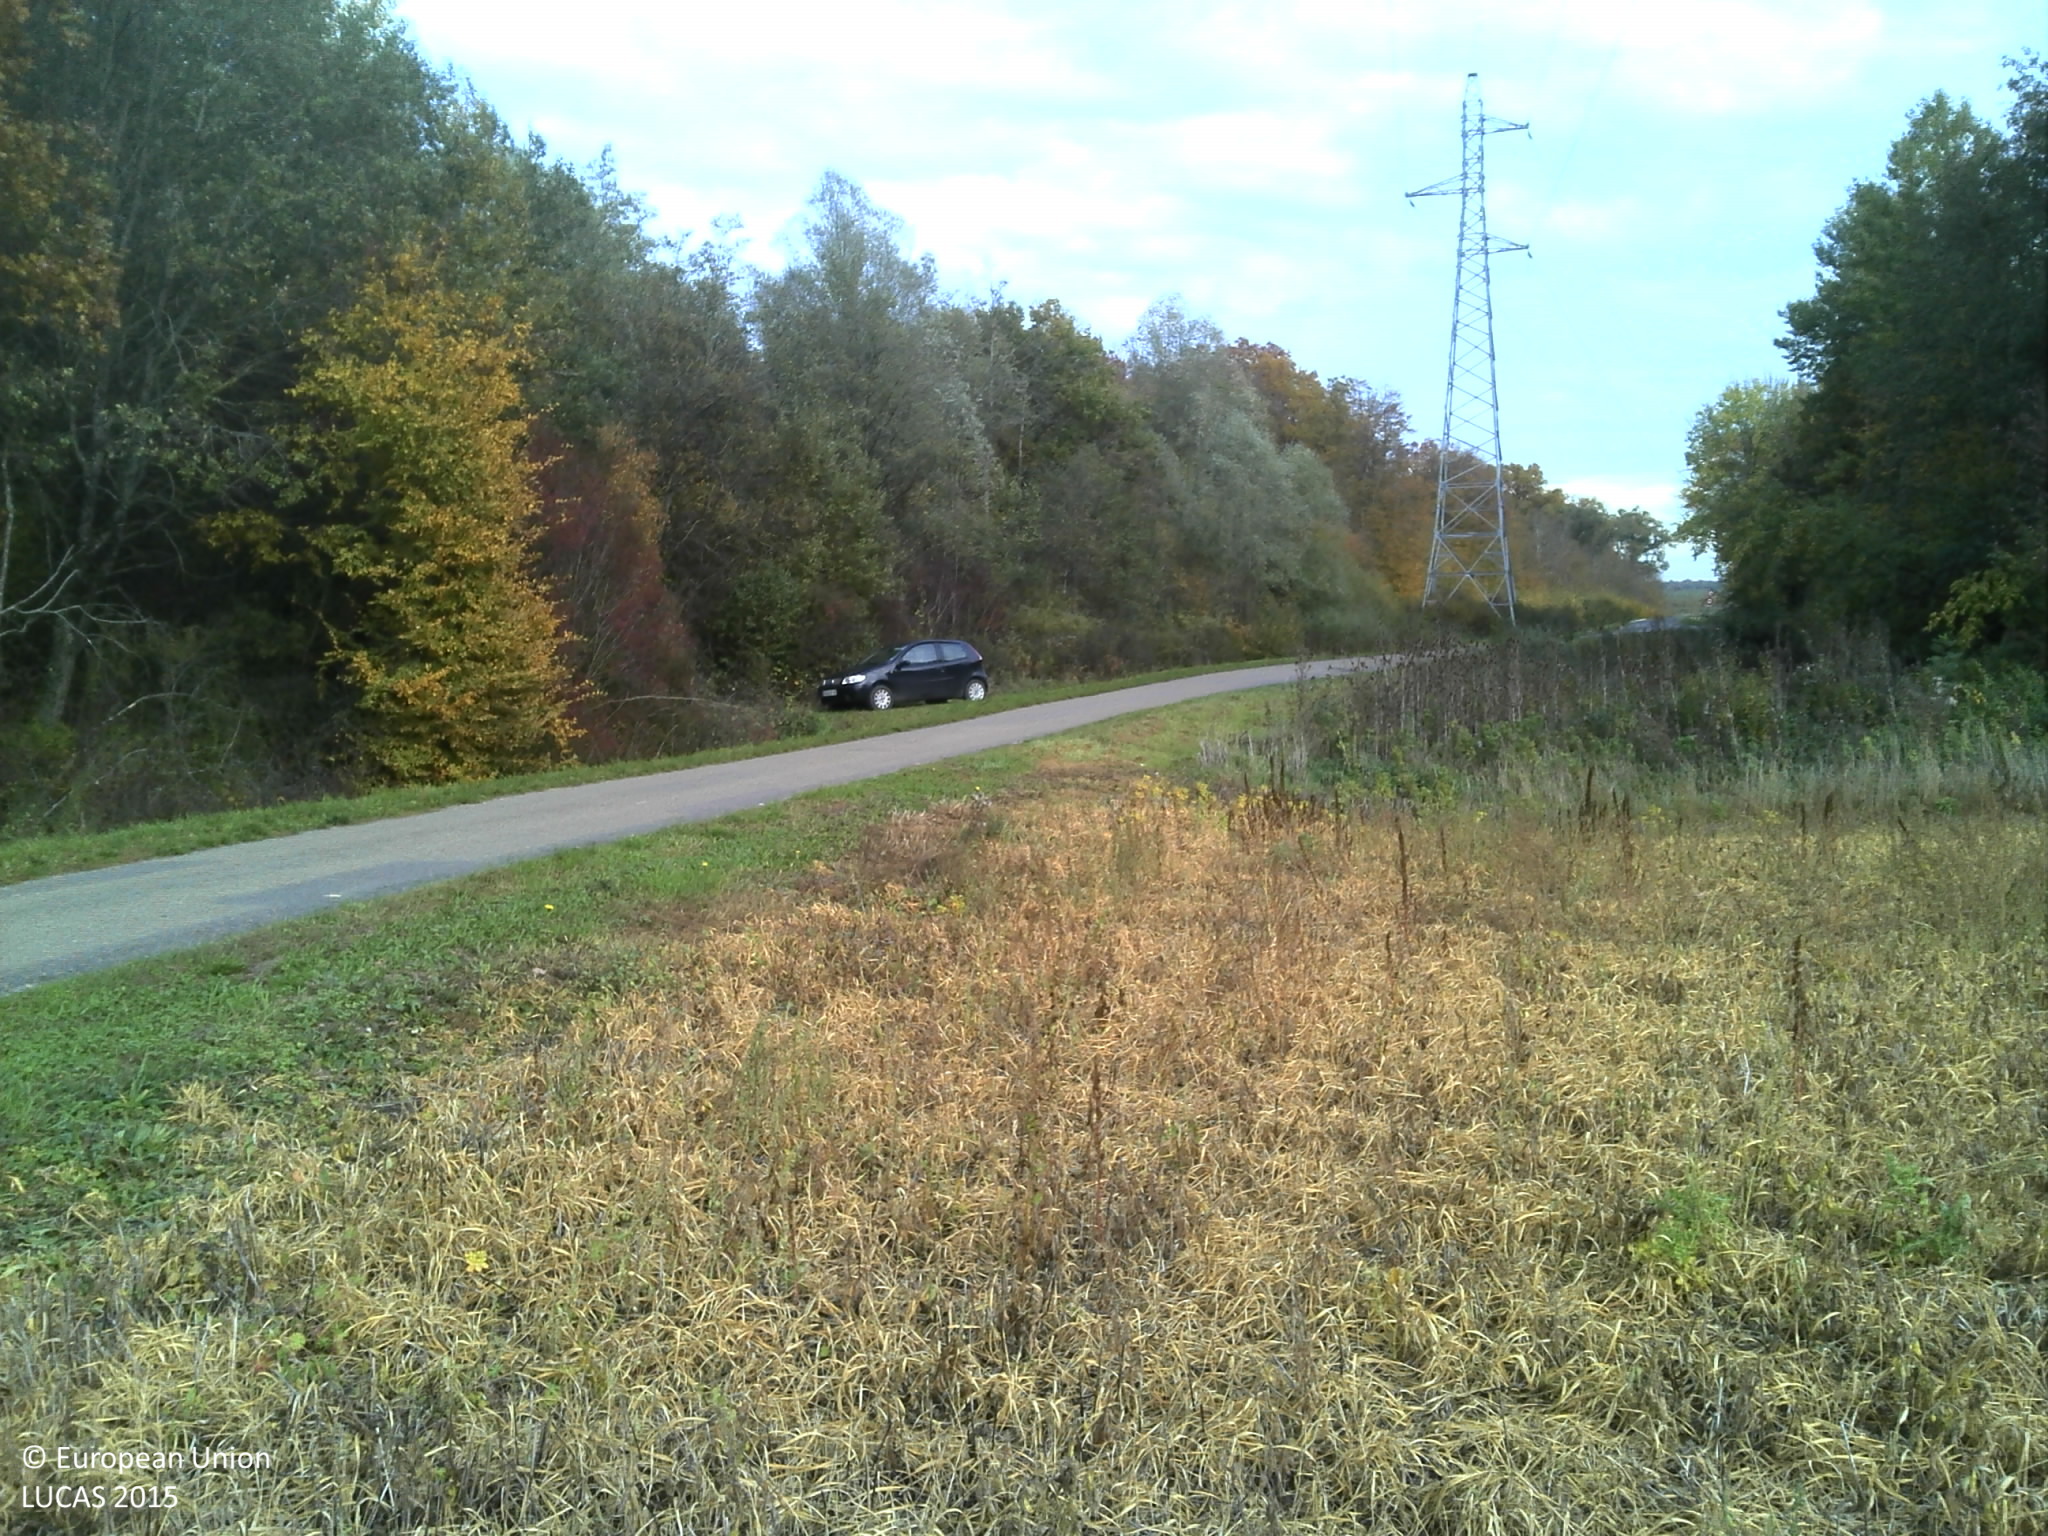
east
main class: Cropland
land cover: Common wheat
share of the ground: 50 - 75 %
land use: Agriculture (excluding fallow land and kitchen gardens)
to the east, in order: Common wheat; Electric lines; Grass margins; Paved roads, cycling and walking lanes; Grass margins; Broadleaved woodland; Rivers and streams; Broadleaved woodland; Grass margins; Tracks; Grass margins; Broadleaved woodland
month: October
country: FR
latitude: 47.0776
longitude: 5.2996
